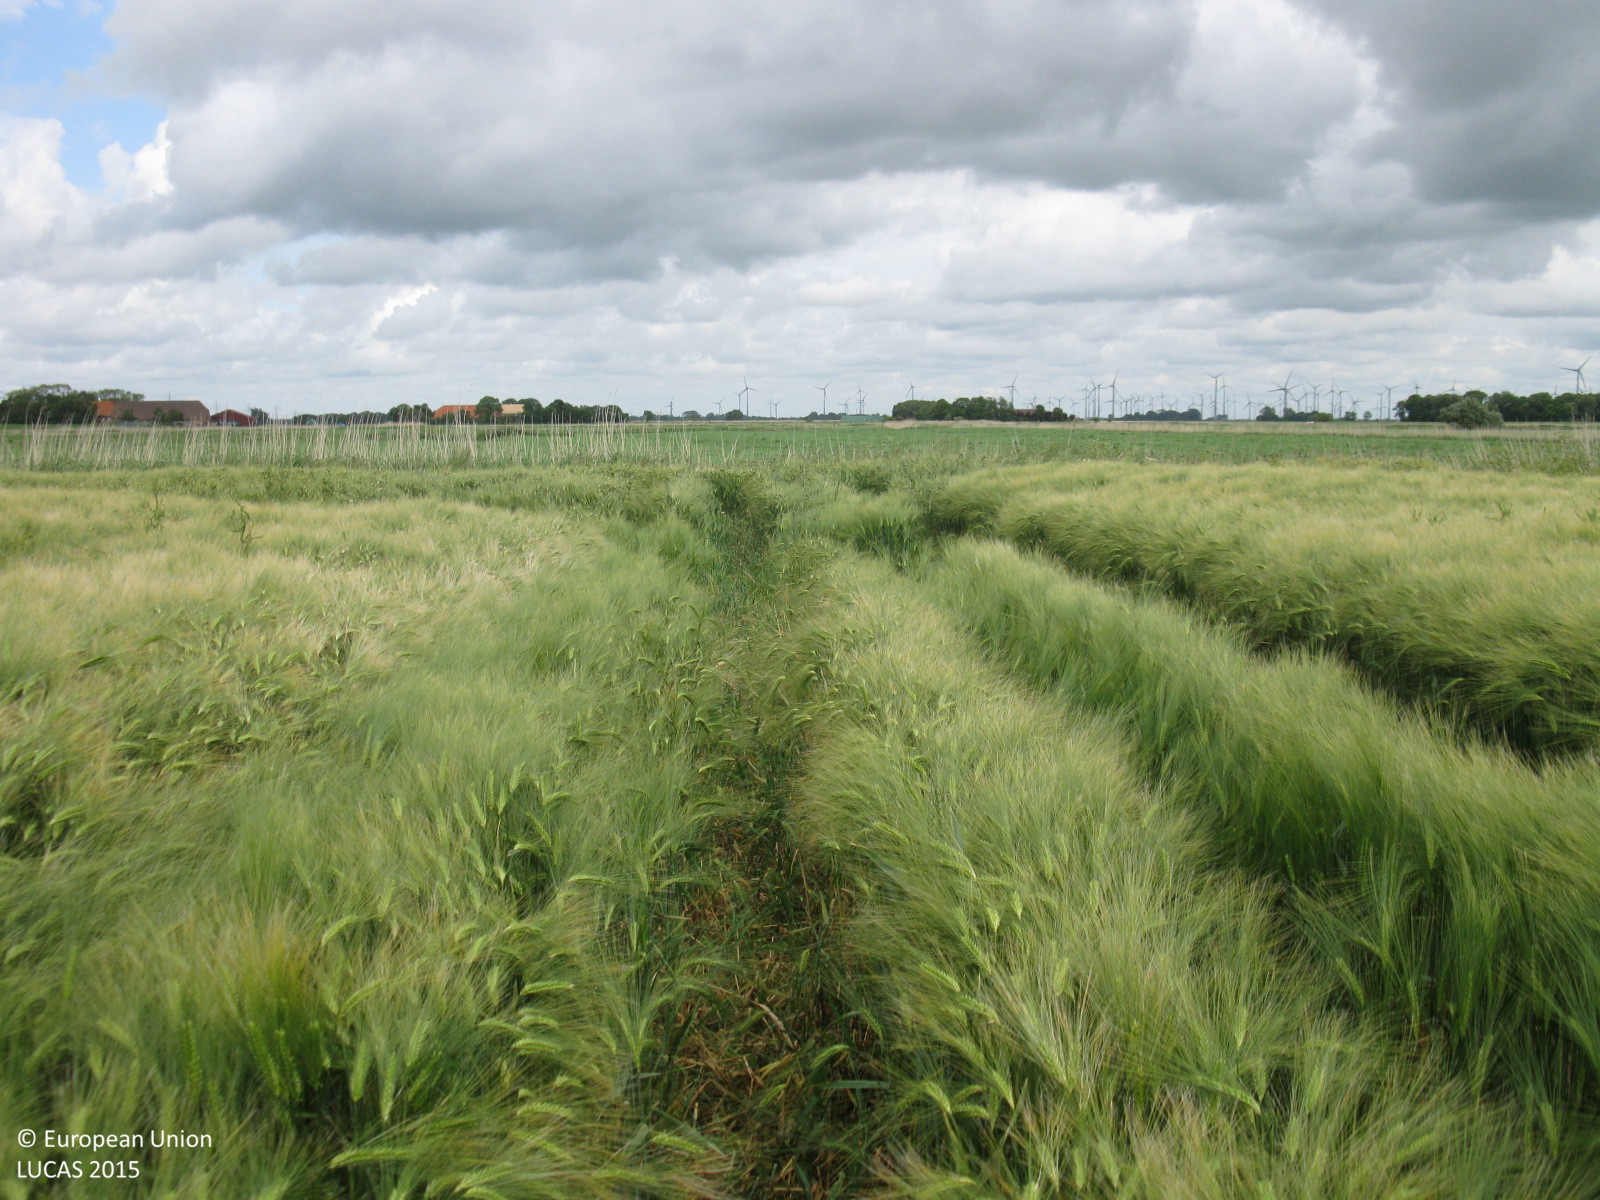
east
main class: Cropland
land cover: Barley
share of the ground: > 75 %
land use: Agriculture (excluding fallow land and kitchen gardens)
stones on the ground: < 10 %
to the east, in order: Barley; Grass margins; Ditches and canals; Grass margins; Paved roads, cycling and walking lanes; Grass margins; Ditches and canals; Grassland without tree/shrub cover; Inland fresh running water; Grassland without tree/shrub cover
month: June
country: DE
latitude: 53.6428
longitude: 7.3536
